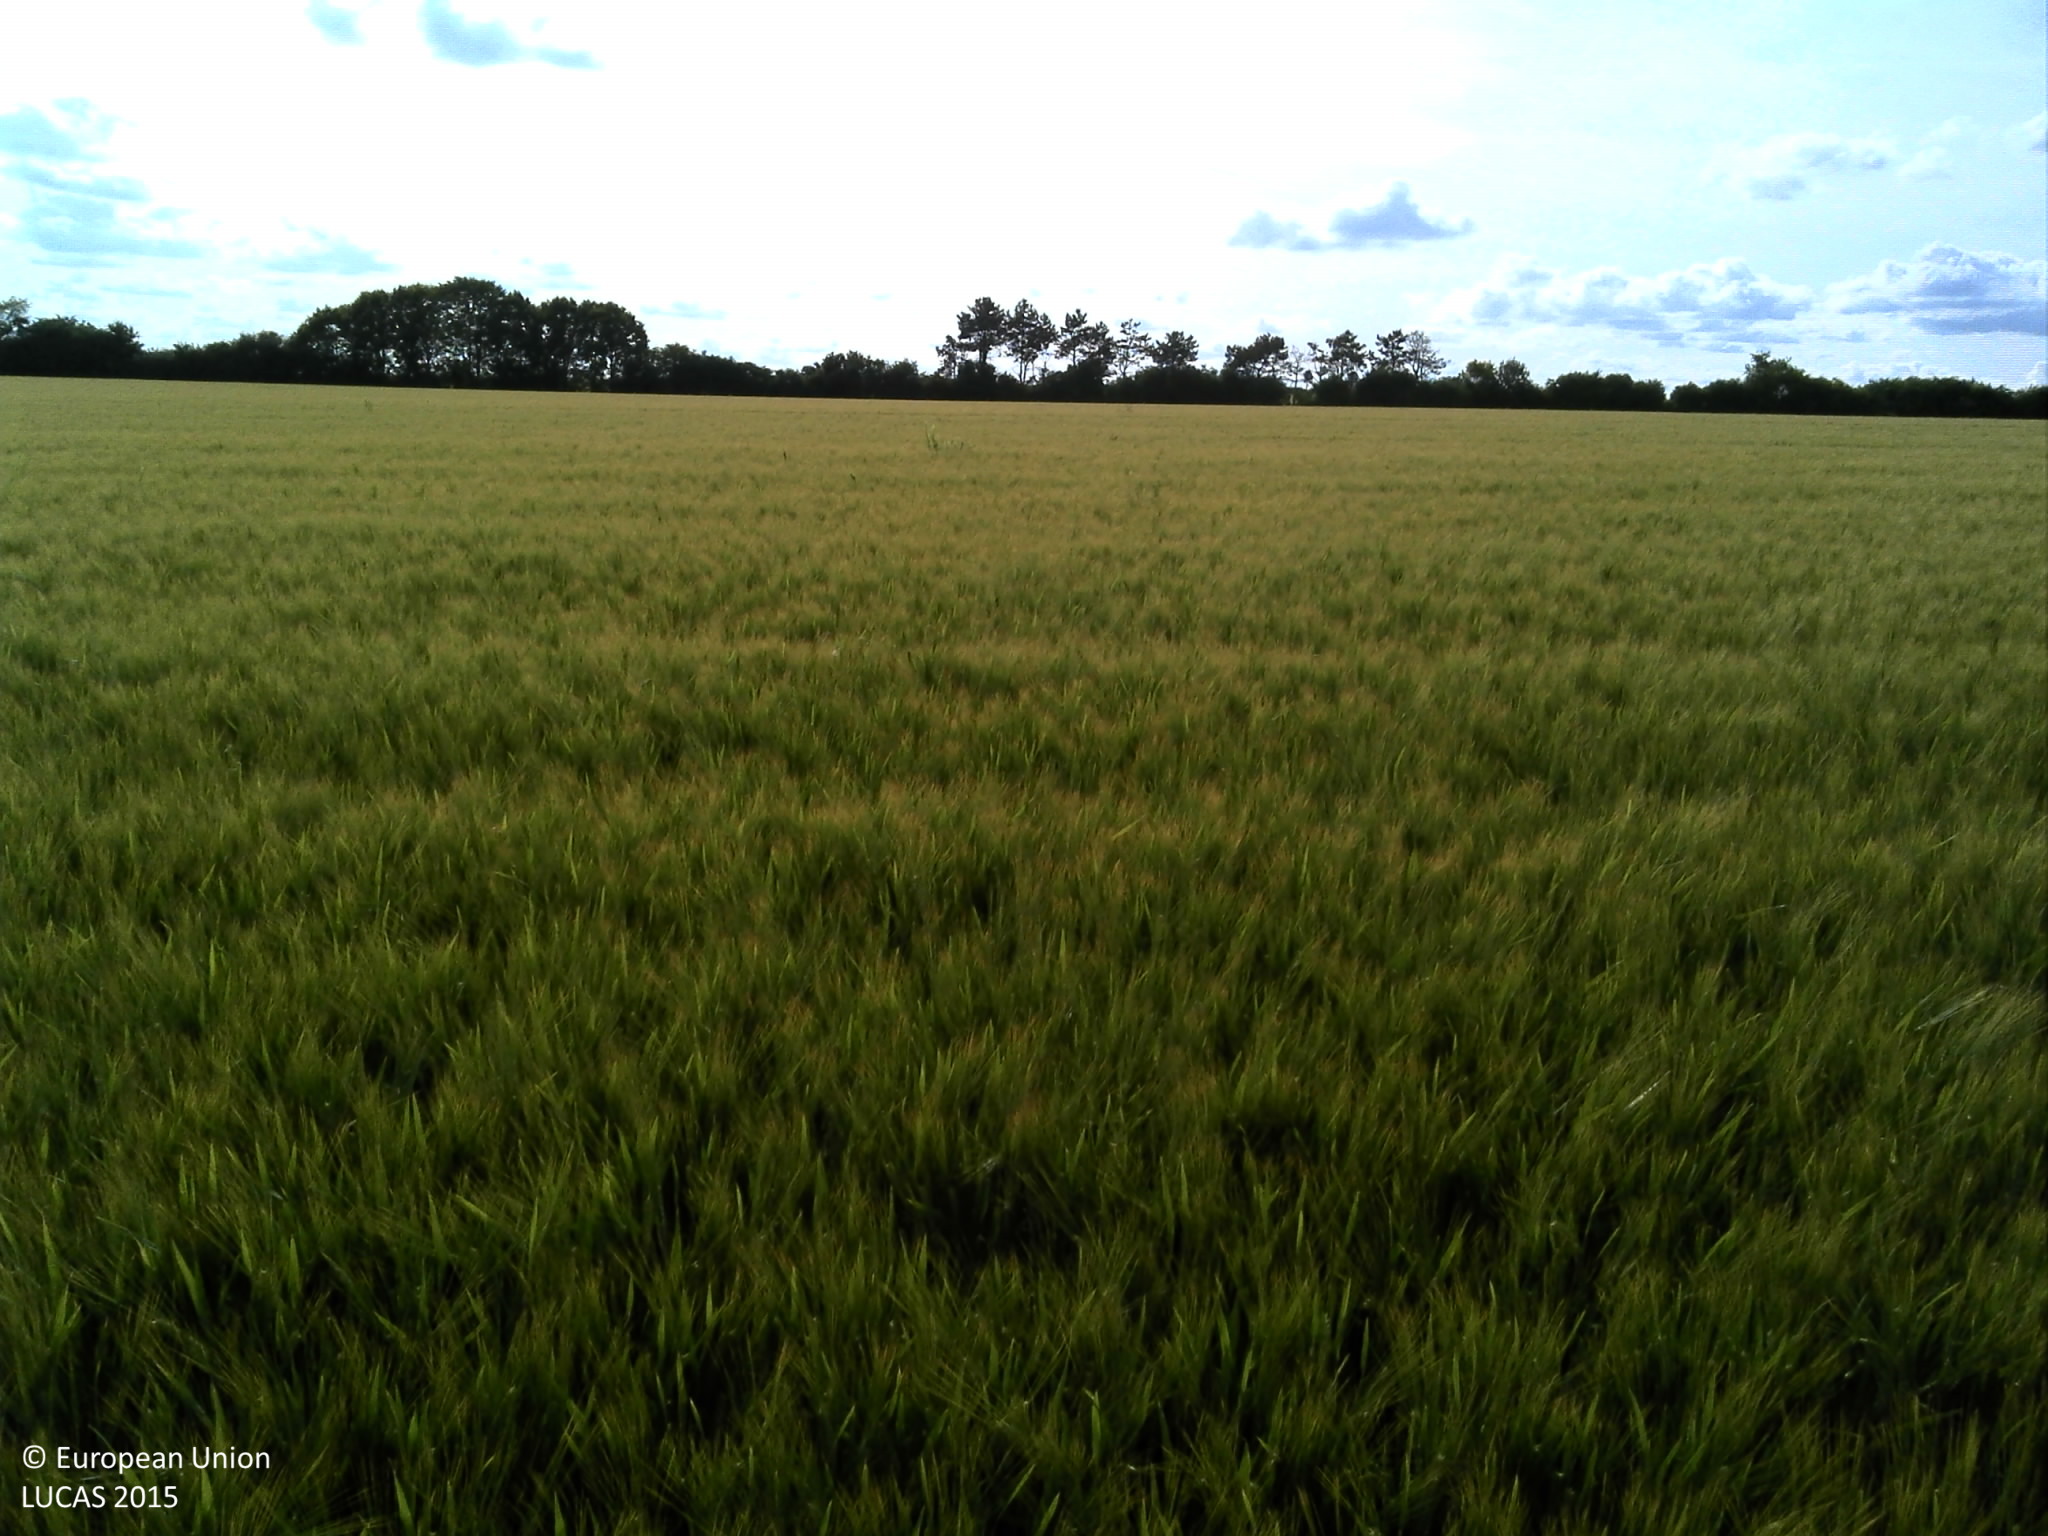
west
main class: Cropland
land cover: Barley
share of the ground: > 75 %
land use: Agriculture (excluding fallow land and kitchen gardens)
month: June
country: FR
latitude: 48.6274
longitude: 4.1484
